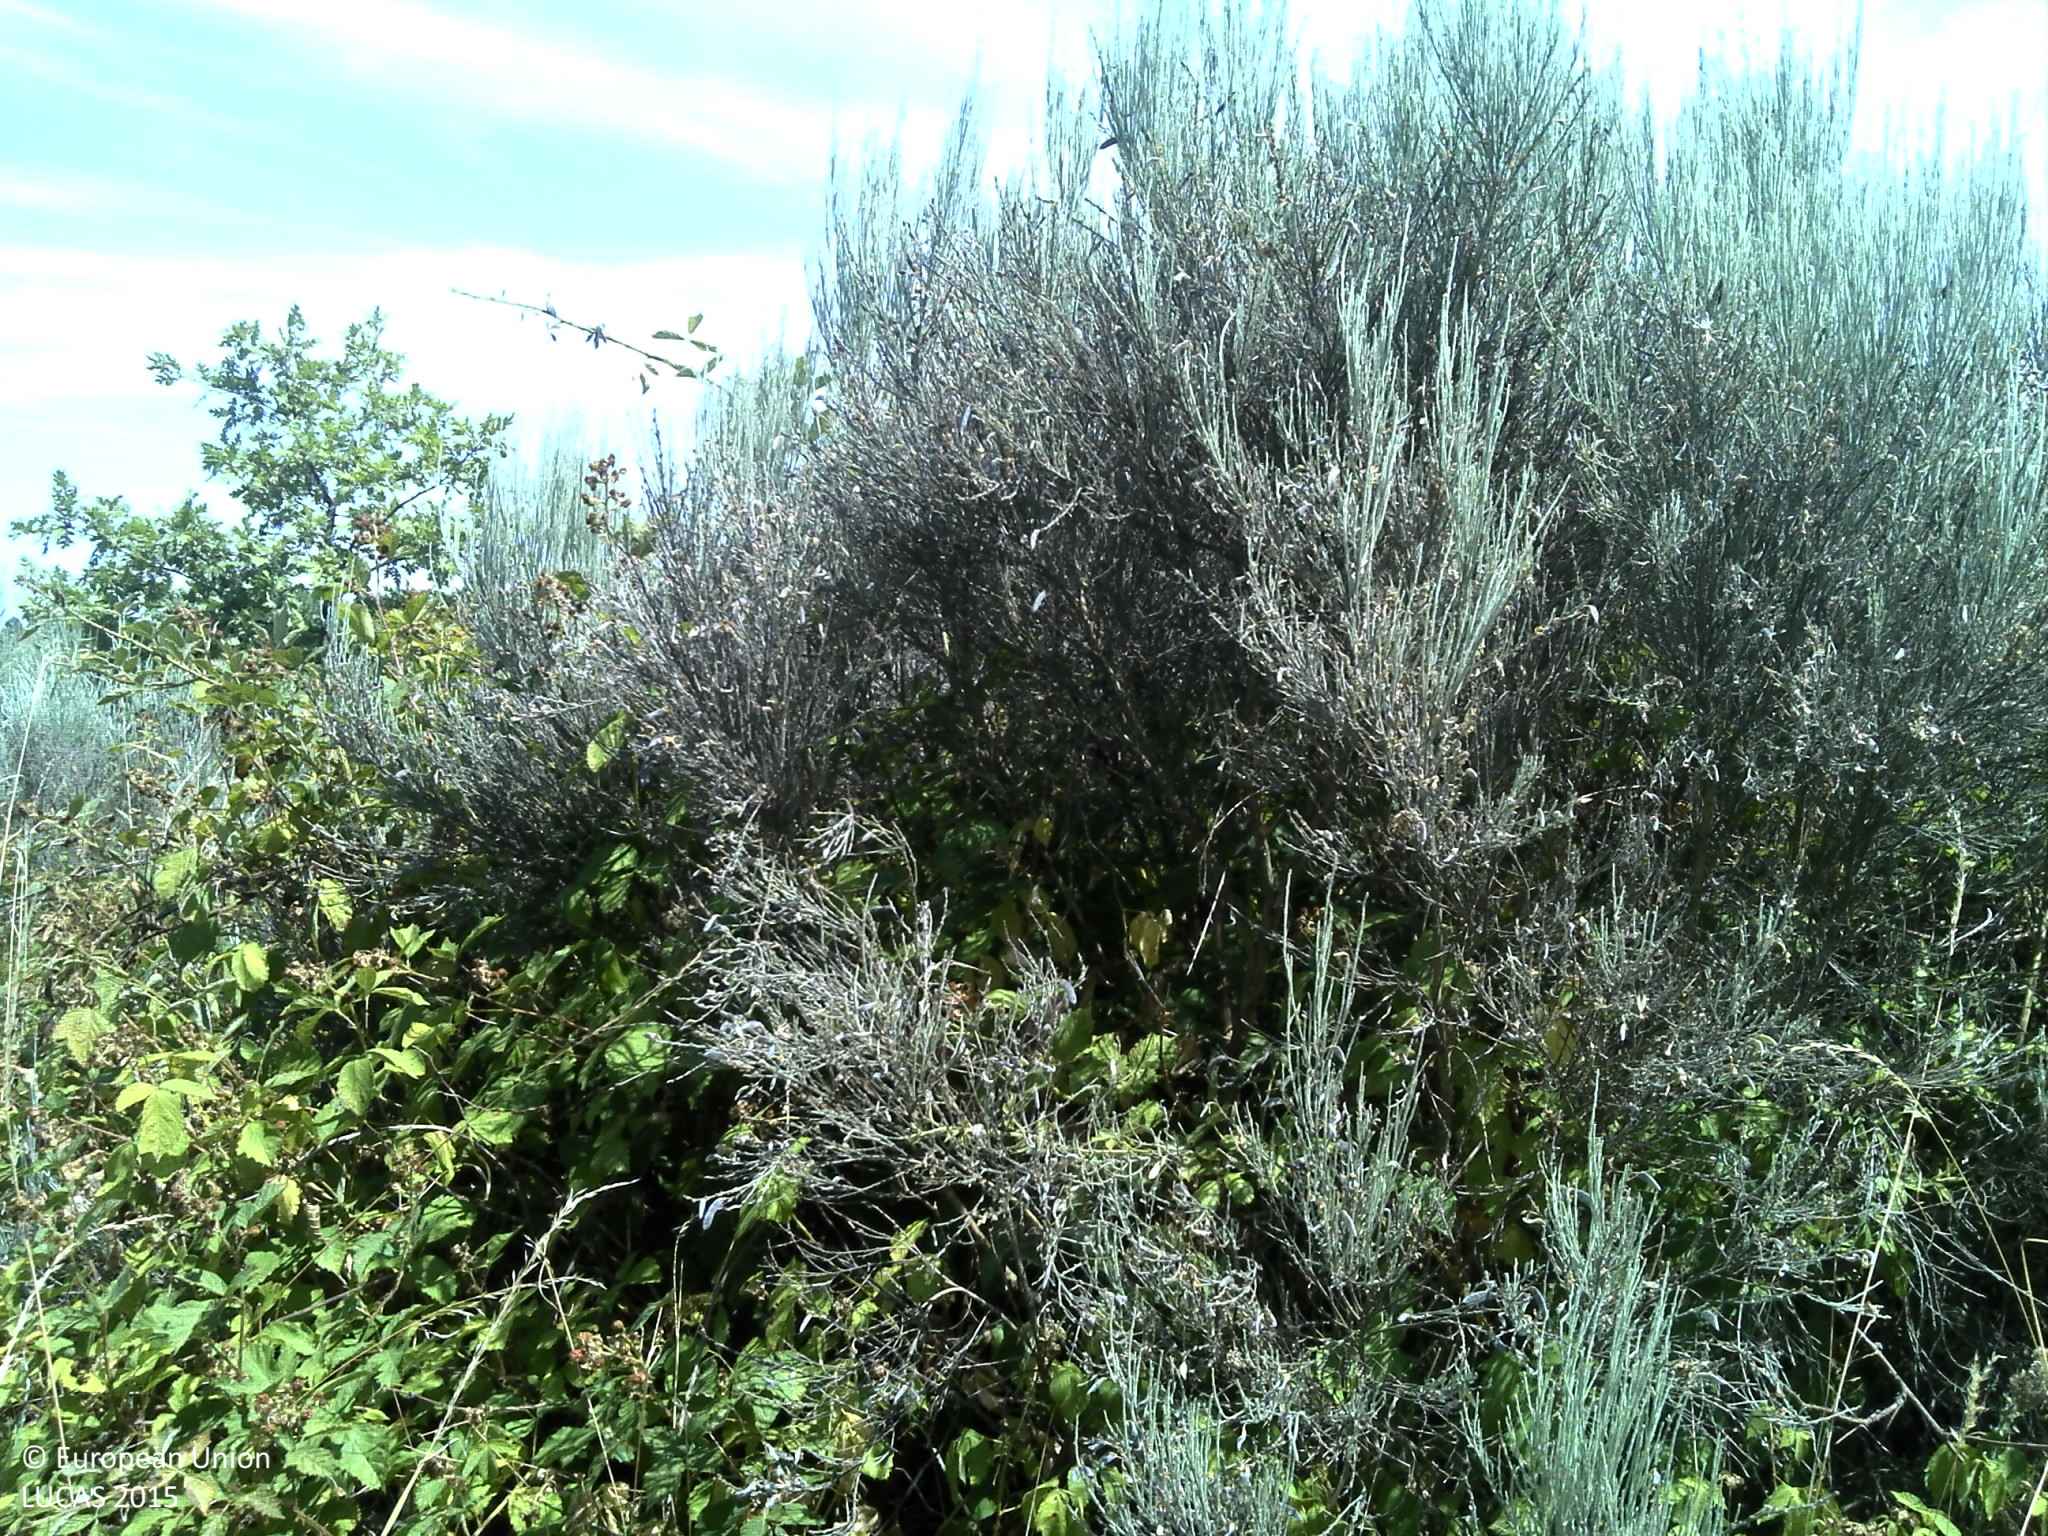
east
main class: Shrubland
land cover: Shrubland with sparse tree cover
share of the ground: > 75 %
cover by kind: shrubs 95 %, coniferous forest trees 5 %
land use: Abandoned areas
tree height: > 5 m
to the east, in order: Shrubland with sparse tree cover; Tracks; Shrubland without tree cover; Shrubland with sparse tree cover; Broadleaved woodland; Shrubland with sparse tree cover; Broadleaved woodland; Shrubland without tree cover
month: July
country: PT
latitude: 40.8310
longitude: -7.3426
